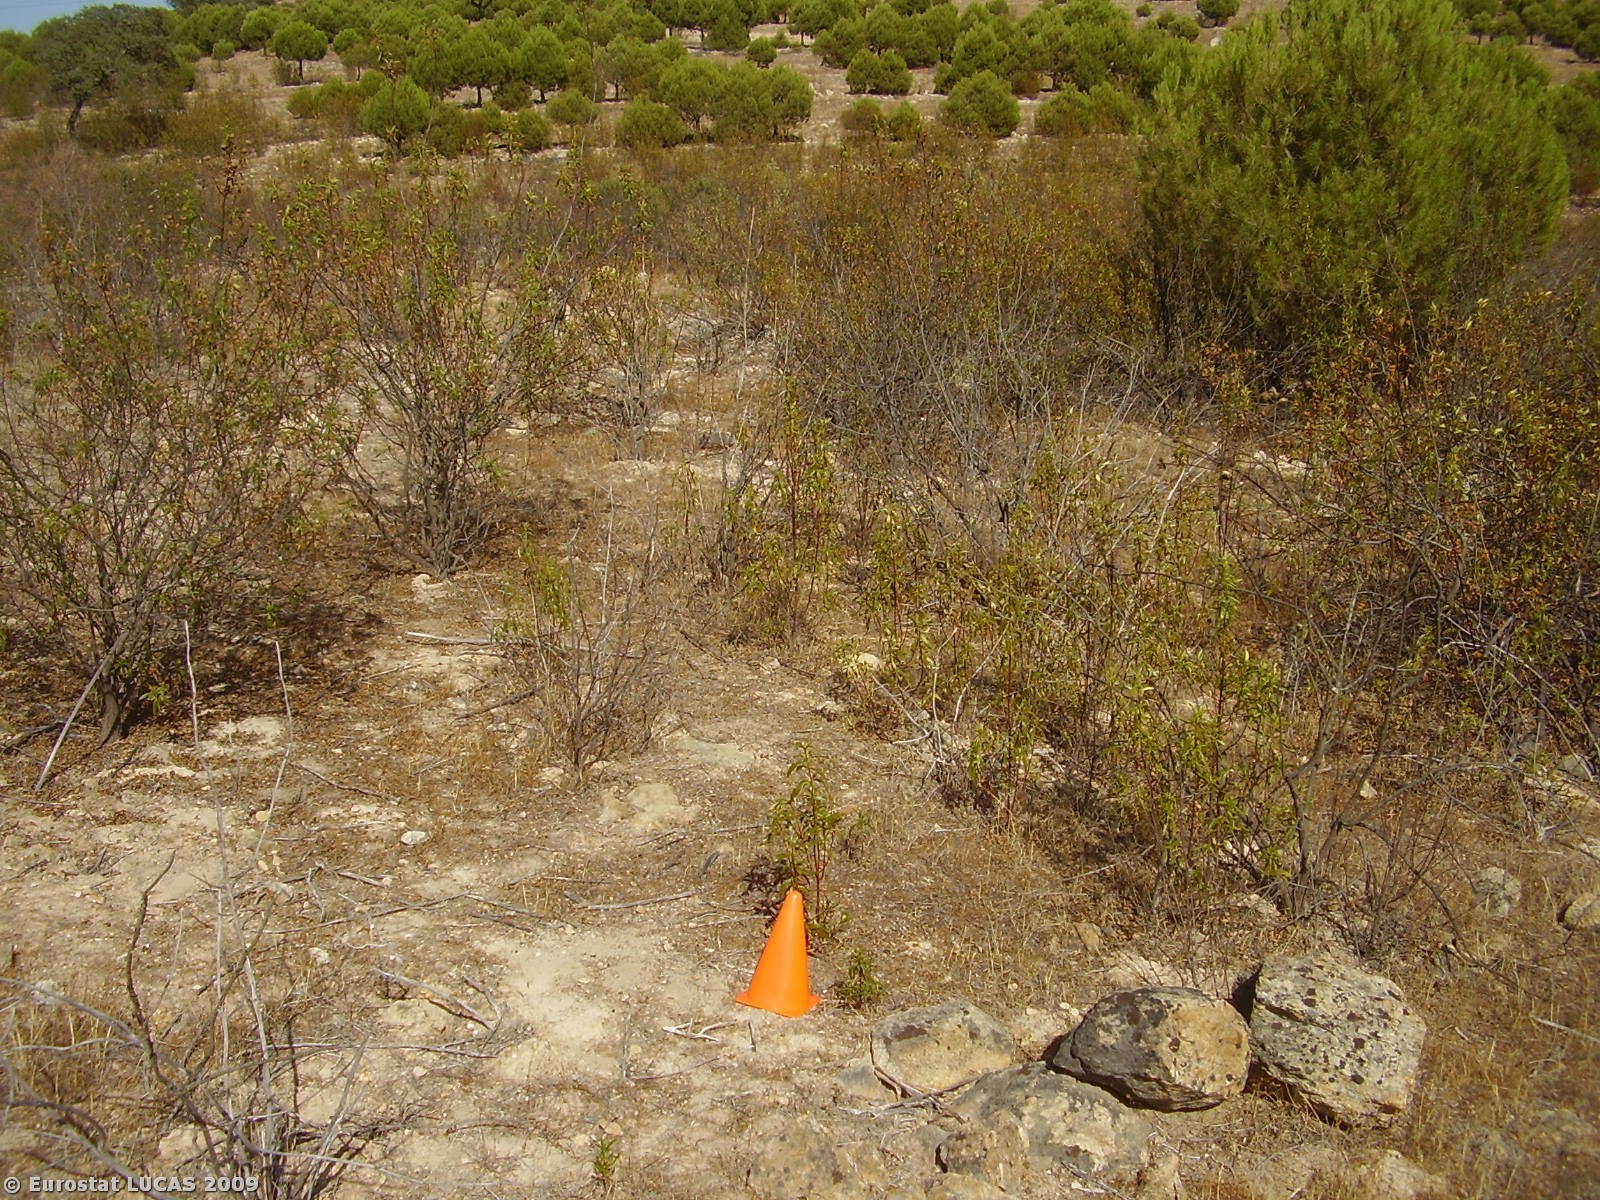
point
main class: Woodland
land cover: Coniferous woodland
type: coniferous forest of the mediterranean region
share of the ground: 10 - 25 %
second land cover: Shrubland with sparse tree cover
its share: 25 - 50 %
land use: Forestry
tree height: > 5 m
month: July
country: PT
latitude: 37.7009
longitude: -7.6999
